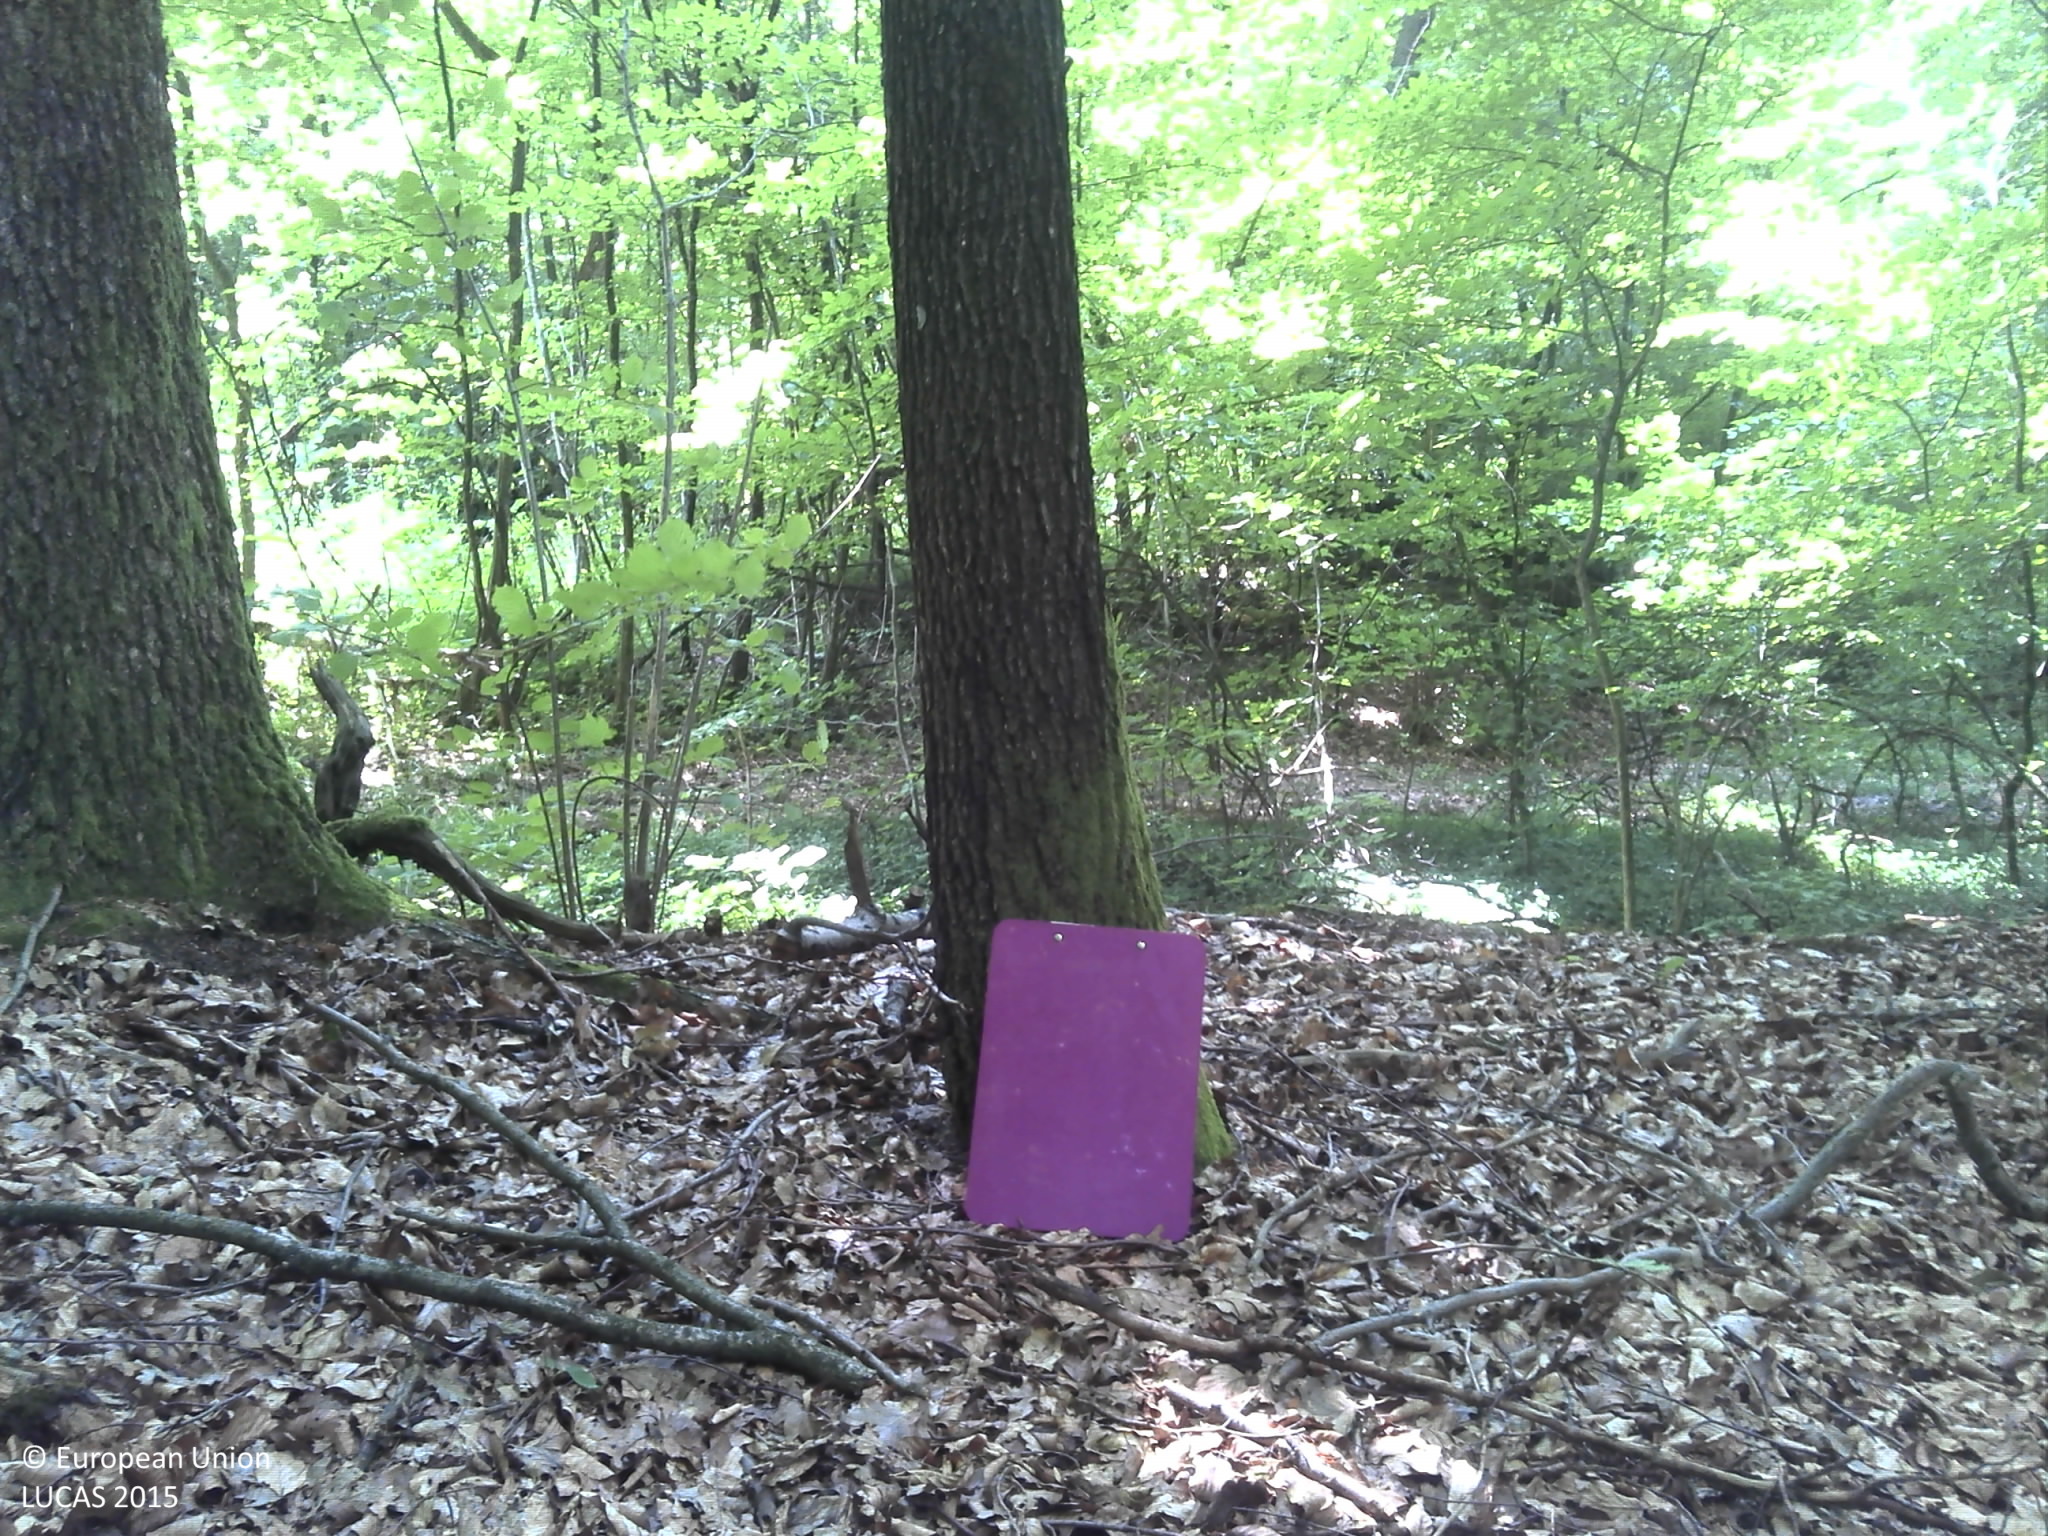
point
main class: Woodland
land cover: Broadleaved woodland
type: beech forest
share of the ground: > 75 %
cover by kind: broadleaved forest trees 80 %, lichens and mosses 20 %
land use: Forestry
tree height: > 5 m
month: June
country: HR
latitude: 45.3839
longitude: 17.2159
